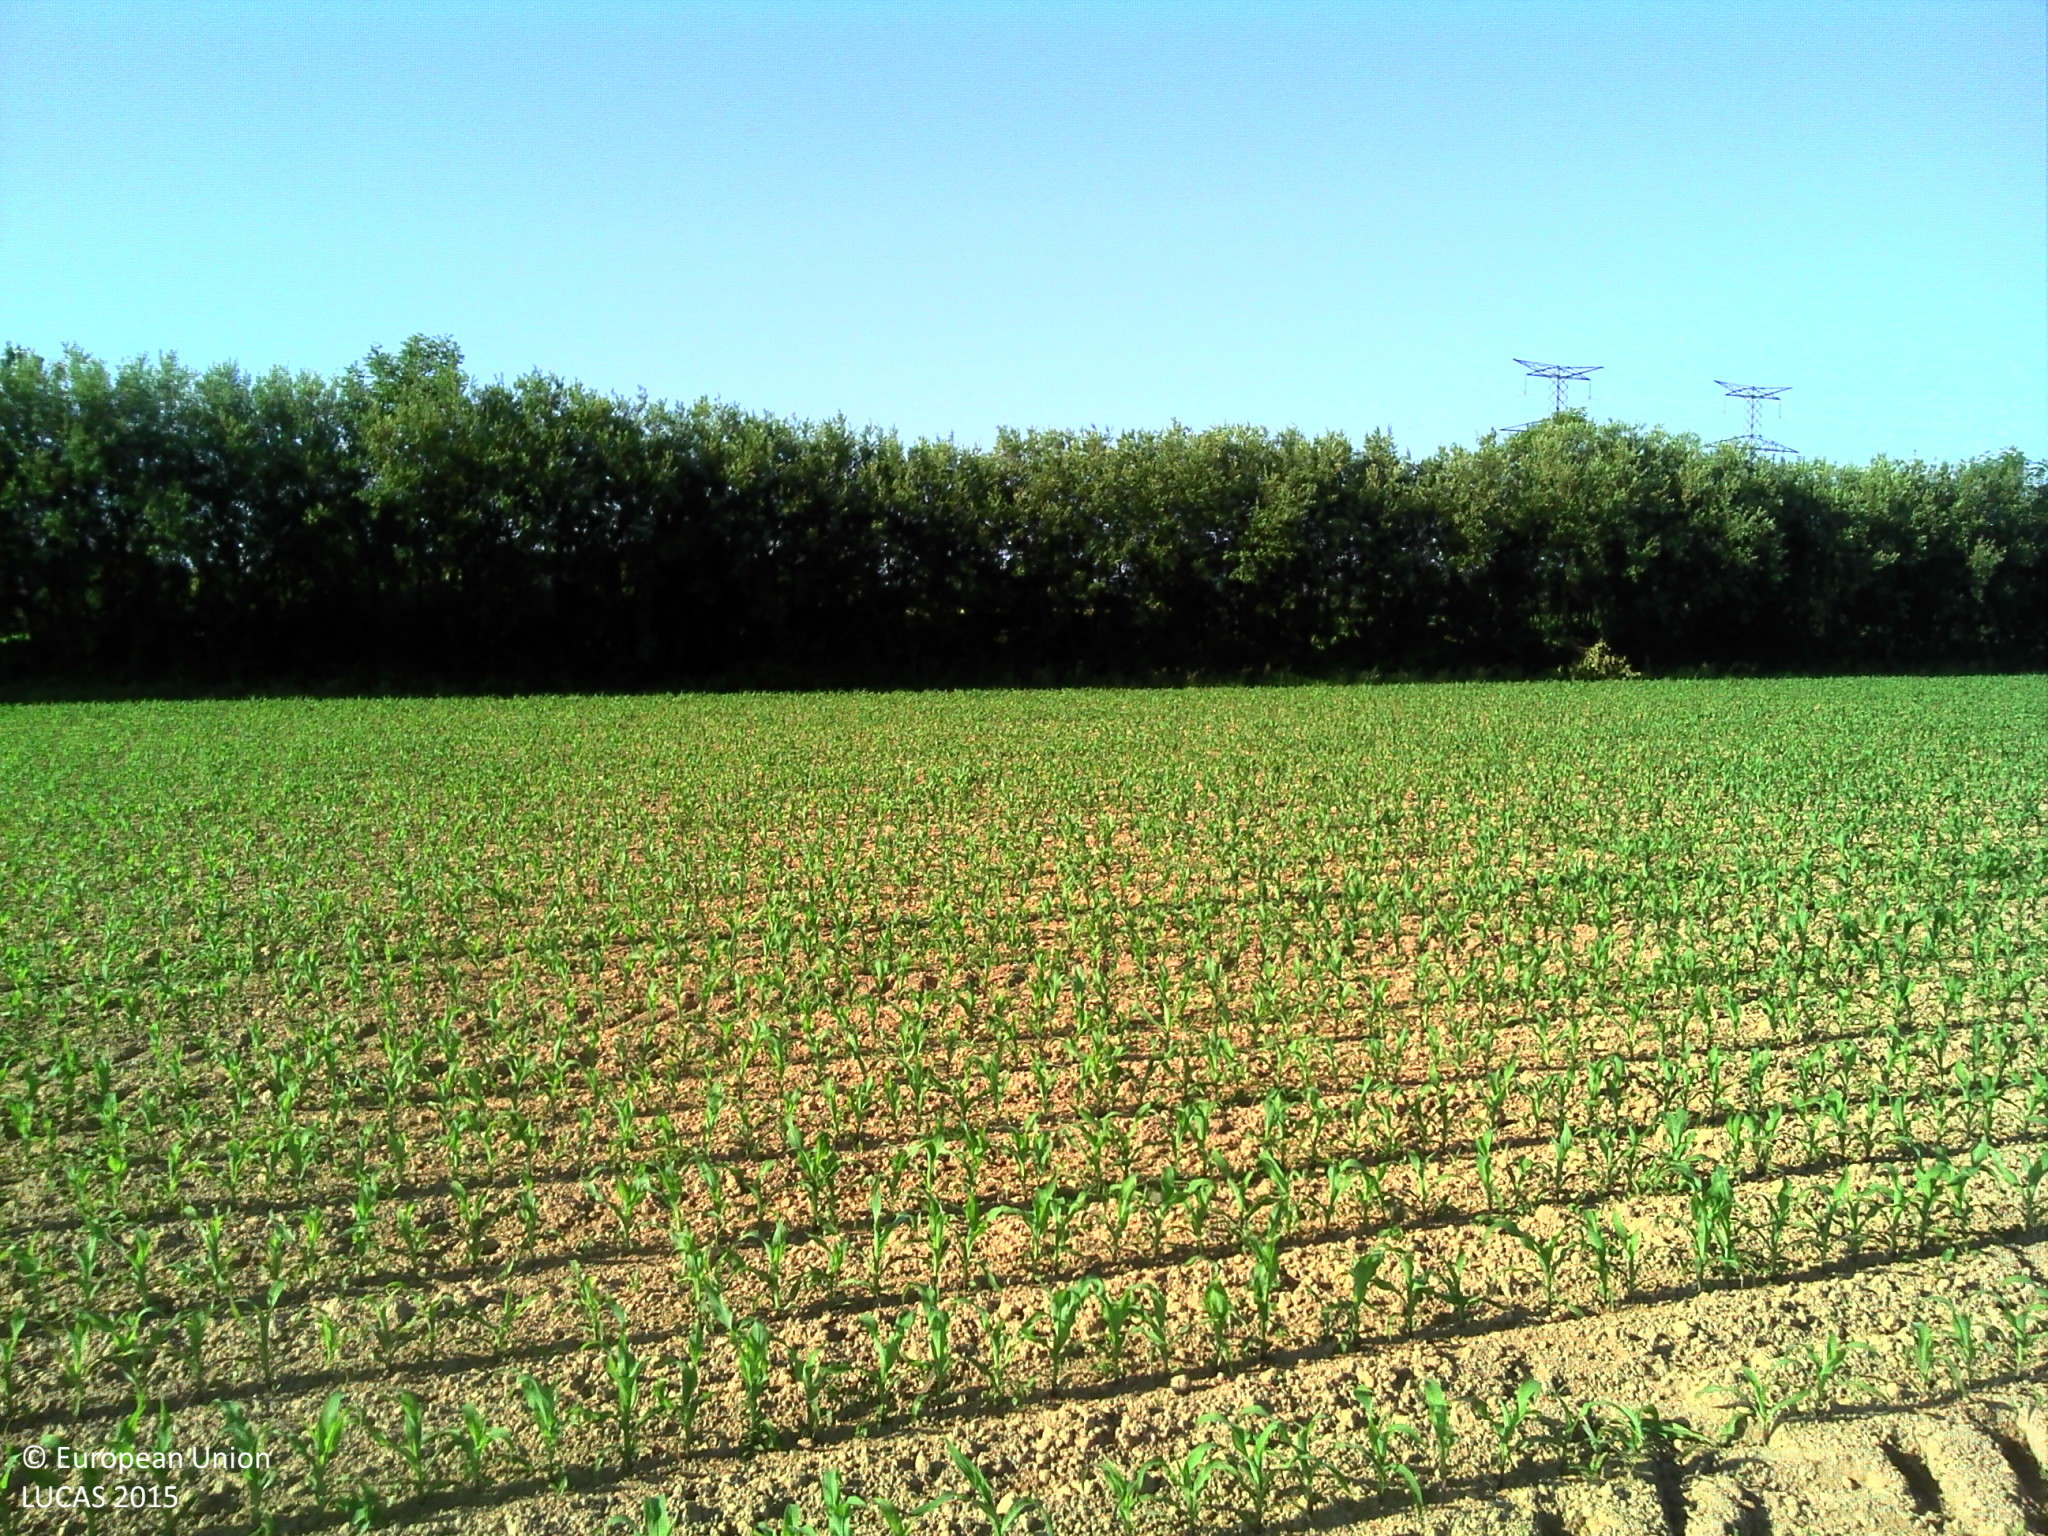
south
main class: Cropland
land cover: Maize
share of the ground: 10 - 25 %
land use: Agriculture (excluding fallow land and kitchen gardens)
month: June
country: FR
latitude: 49.3293
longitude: -1.4835
